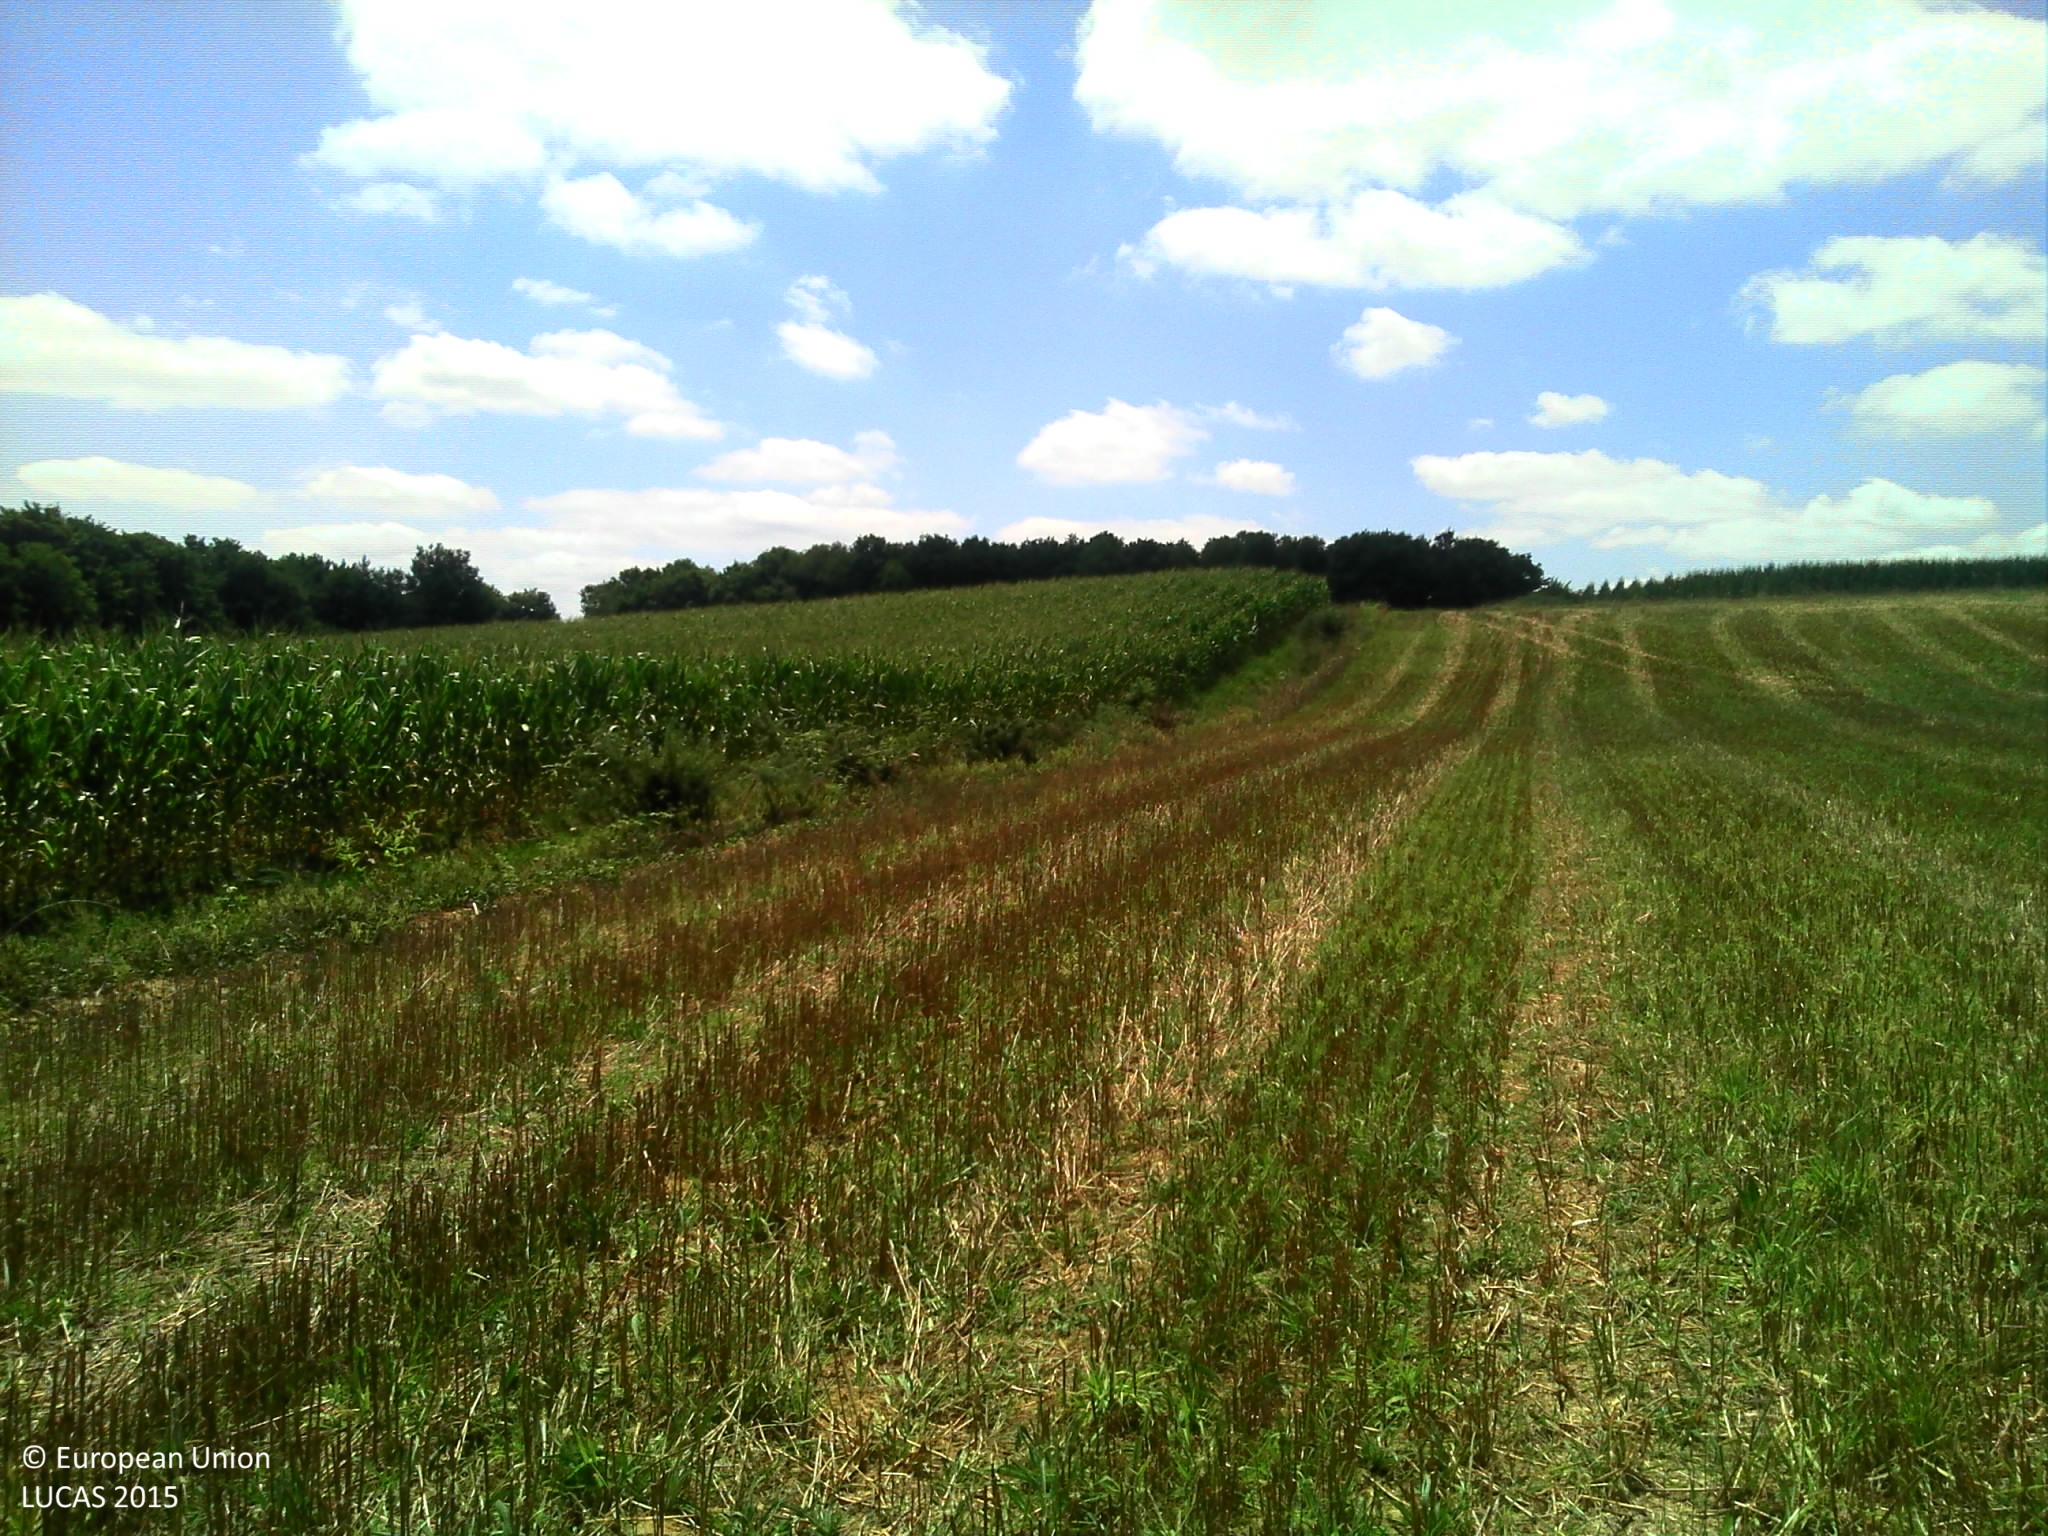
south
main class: Cropland
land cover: Temporary grasslands
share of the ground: > 75 %
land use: Agriculture (excluding fallow land and kitchen gardens)
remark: Harvested field
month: July
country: FR
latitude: 43.5181
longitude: -1.0868
